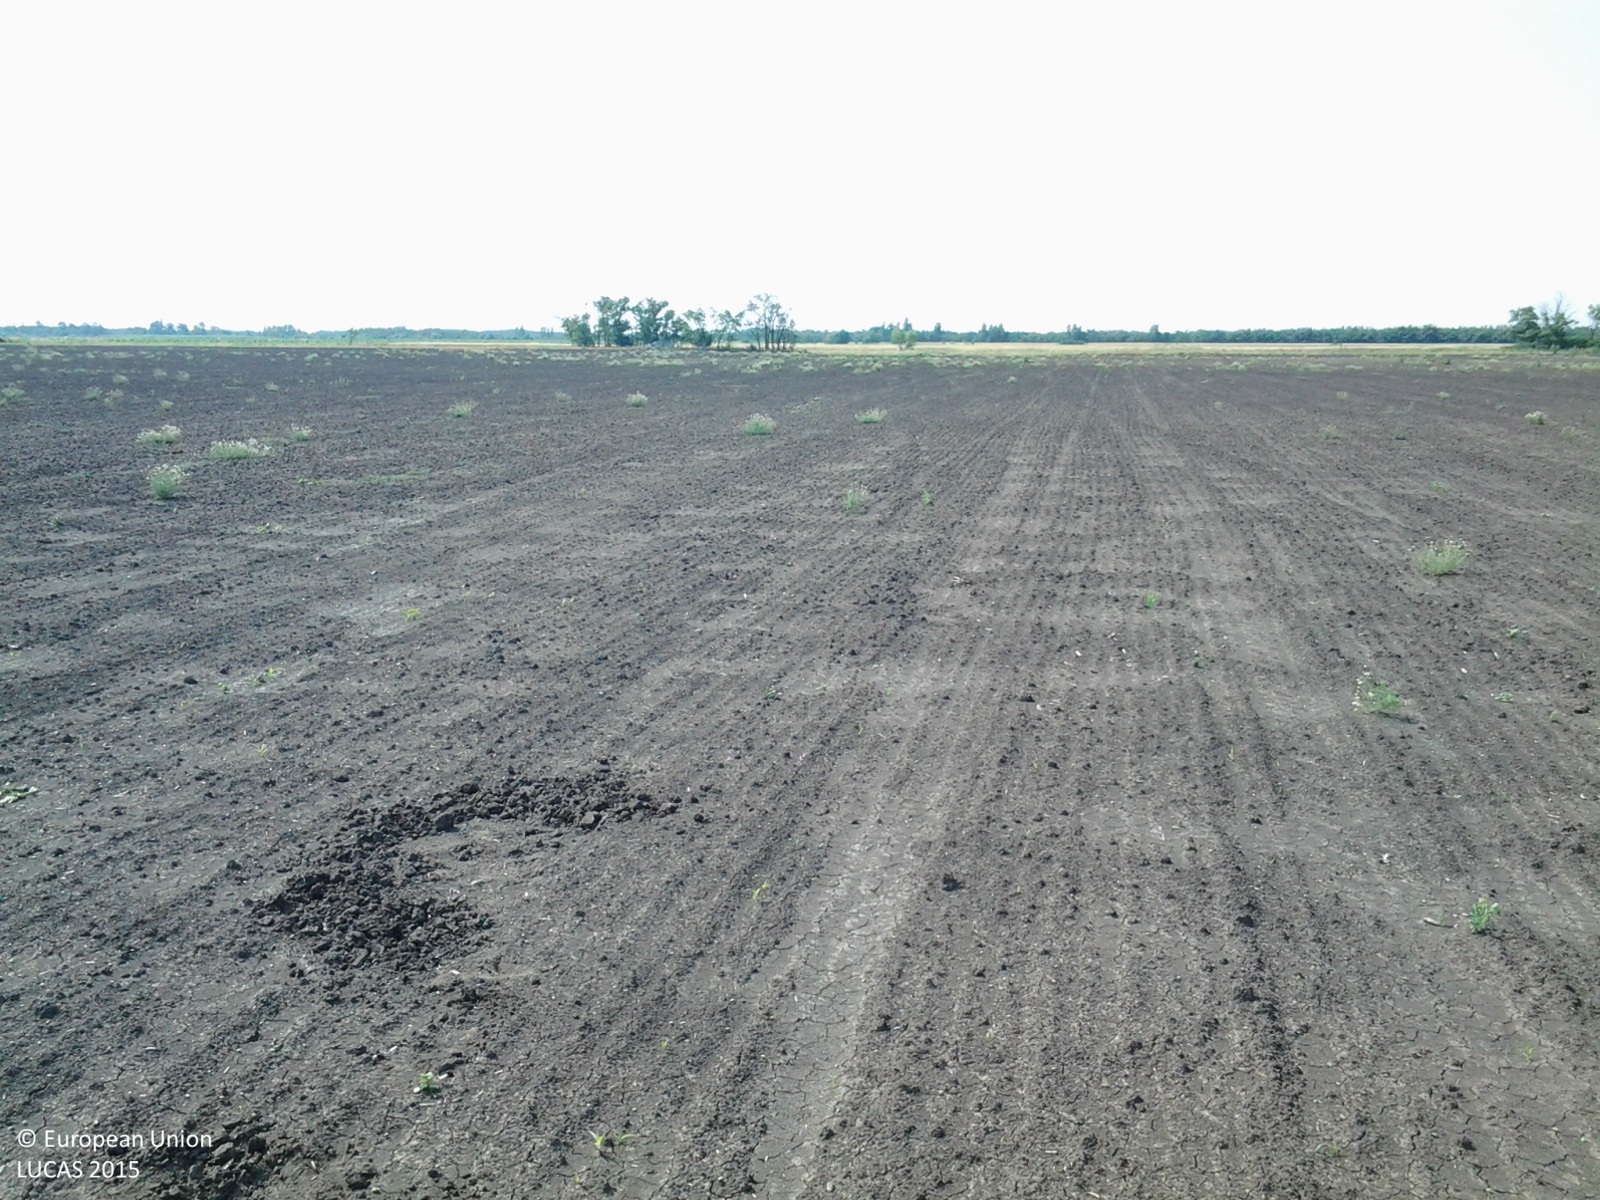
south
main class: Cropland
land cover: Maize
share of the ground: < 10 %
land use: Agriculture (excluding fallow land and kitchen gardens)
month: July
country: HU
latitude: 46.9812
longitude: 20.4535
